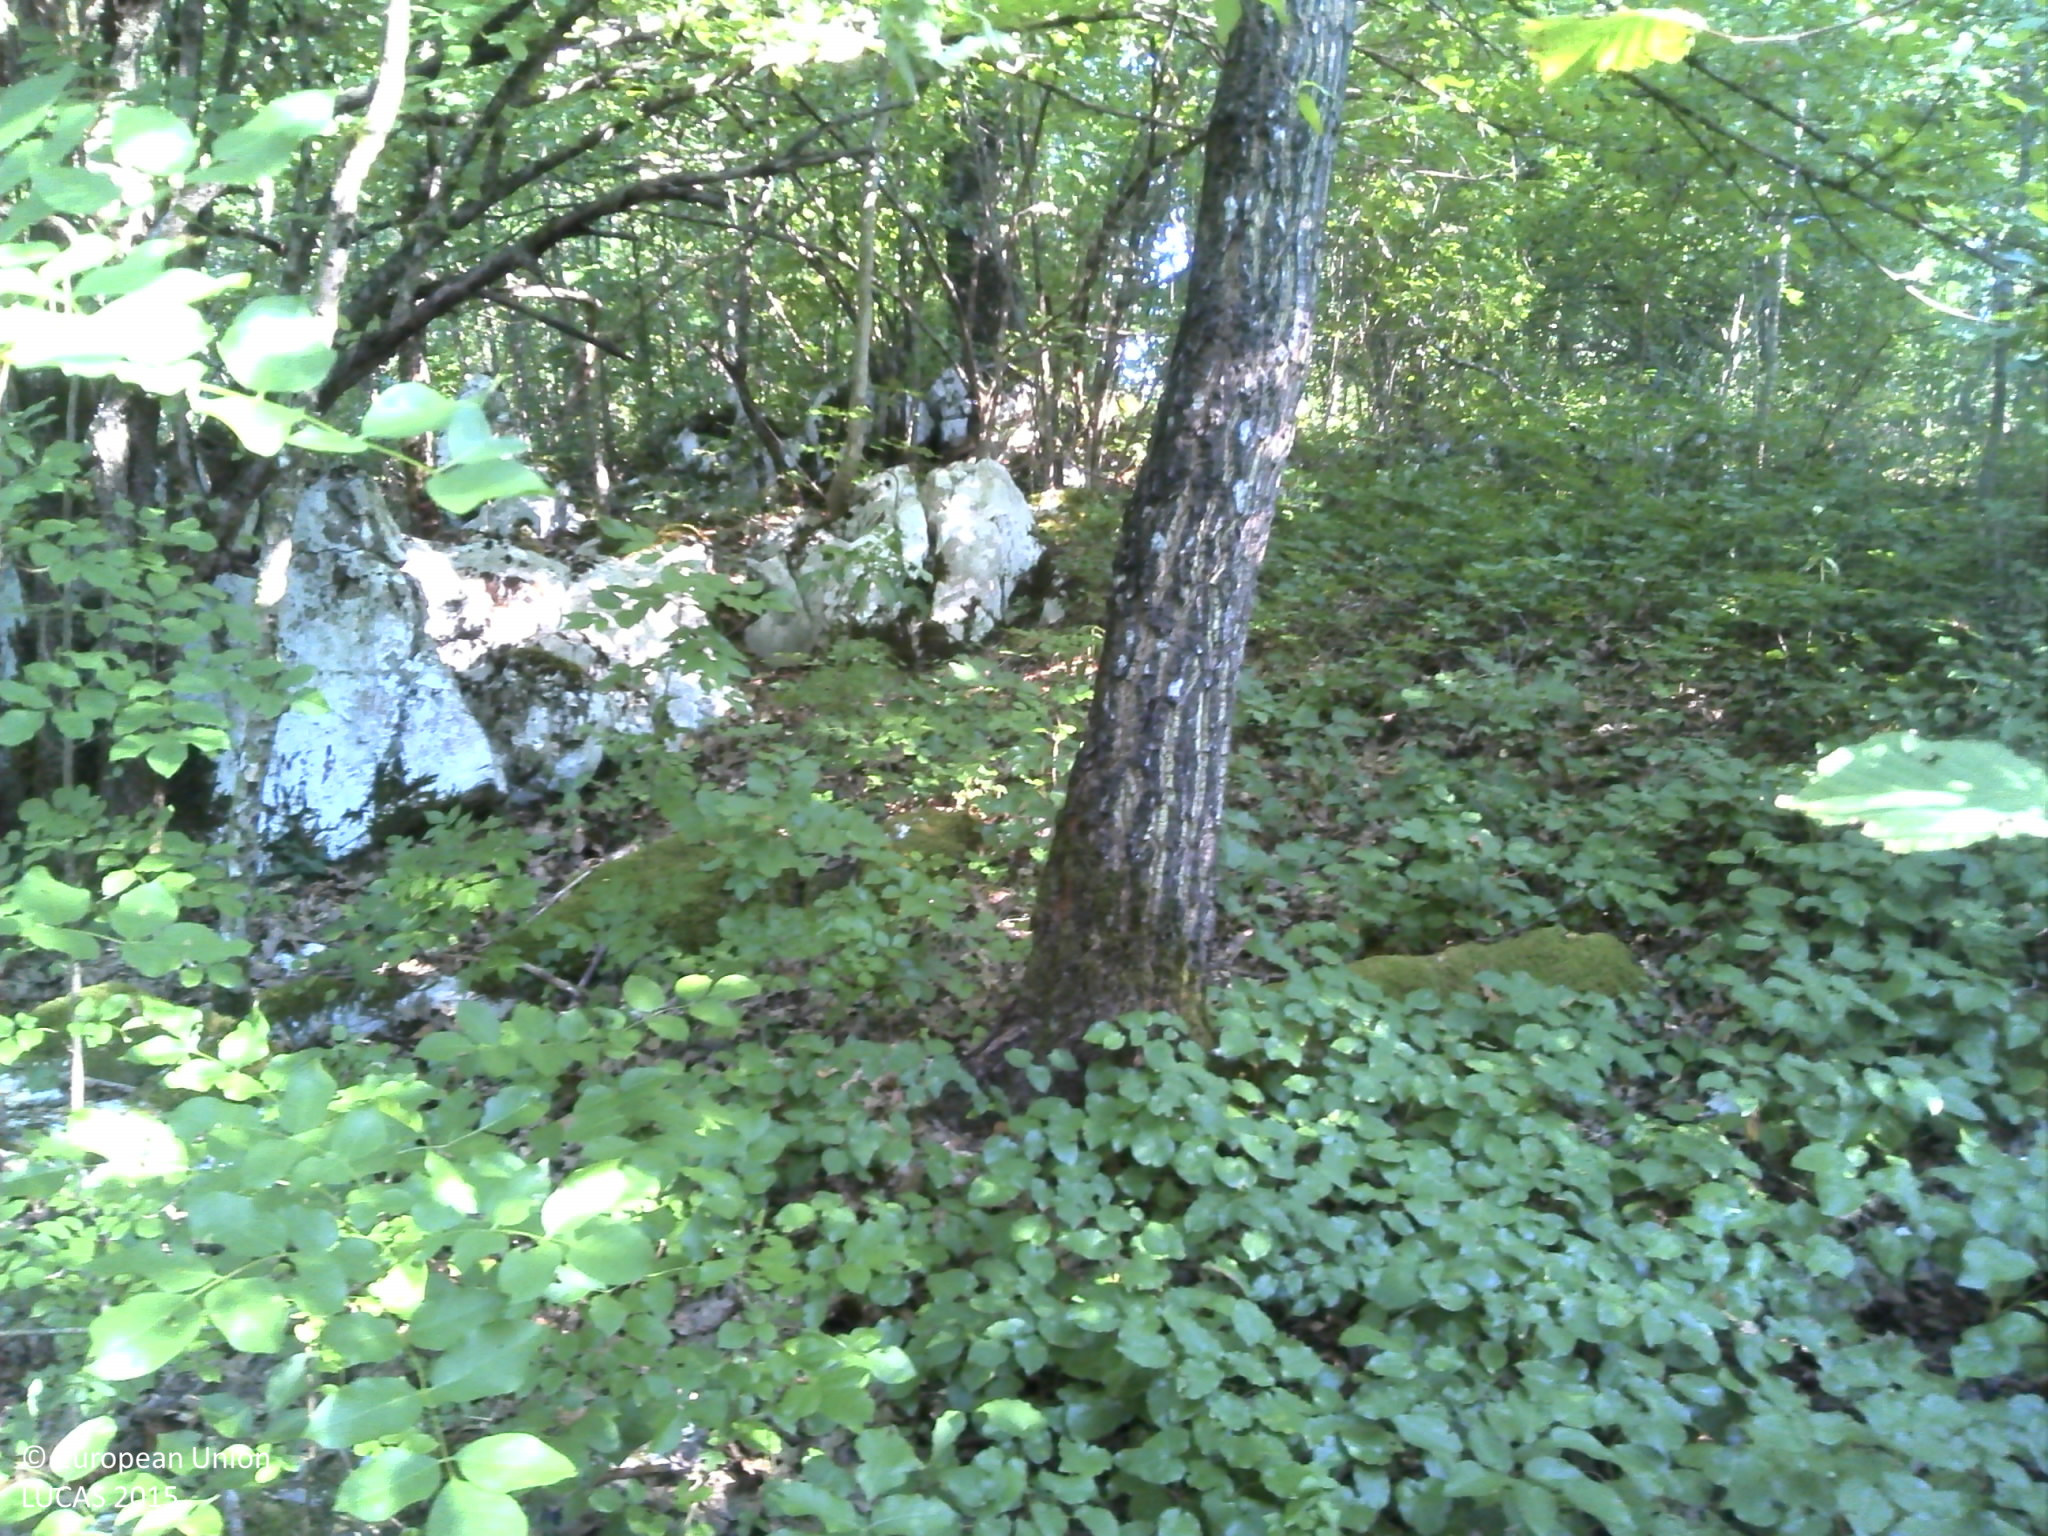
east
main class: Woodland
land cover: Broadleaved woodland
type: acidophilous oak and oak-birch forest
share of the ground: > 75 %
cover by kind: broadleaved forest trees 100 %
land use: Forestry
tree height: > 5 m
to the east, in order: Broadleaved woodland
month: September
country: HR
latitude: 45.3356
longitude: 15.2912
